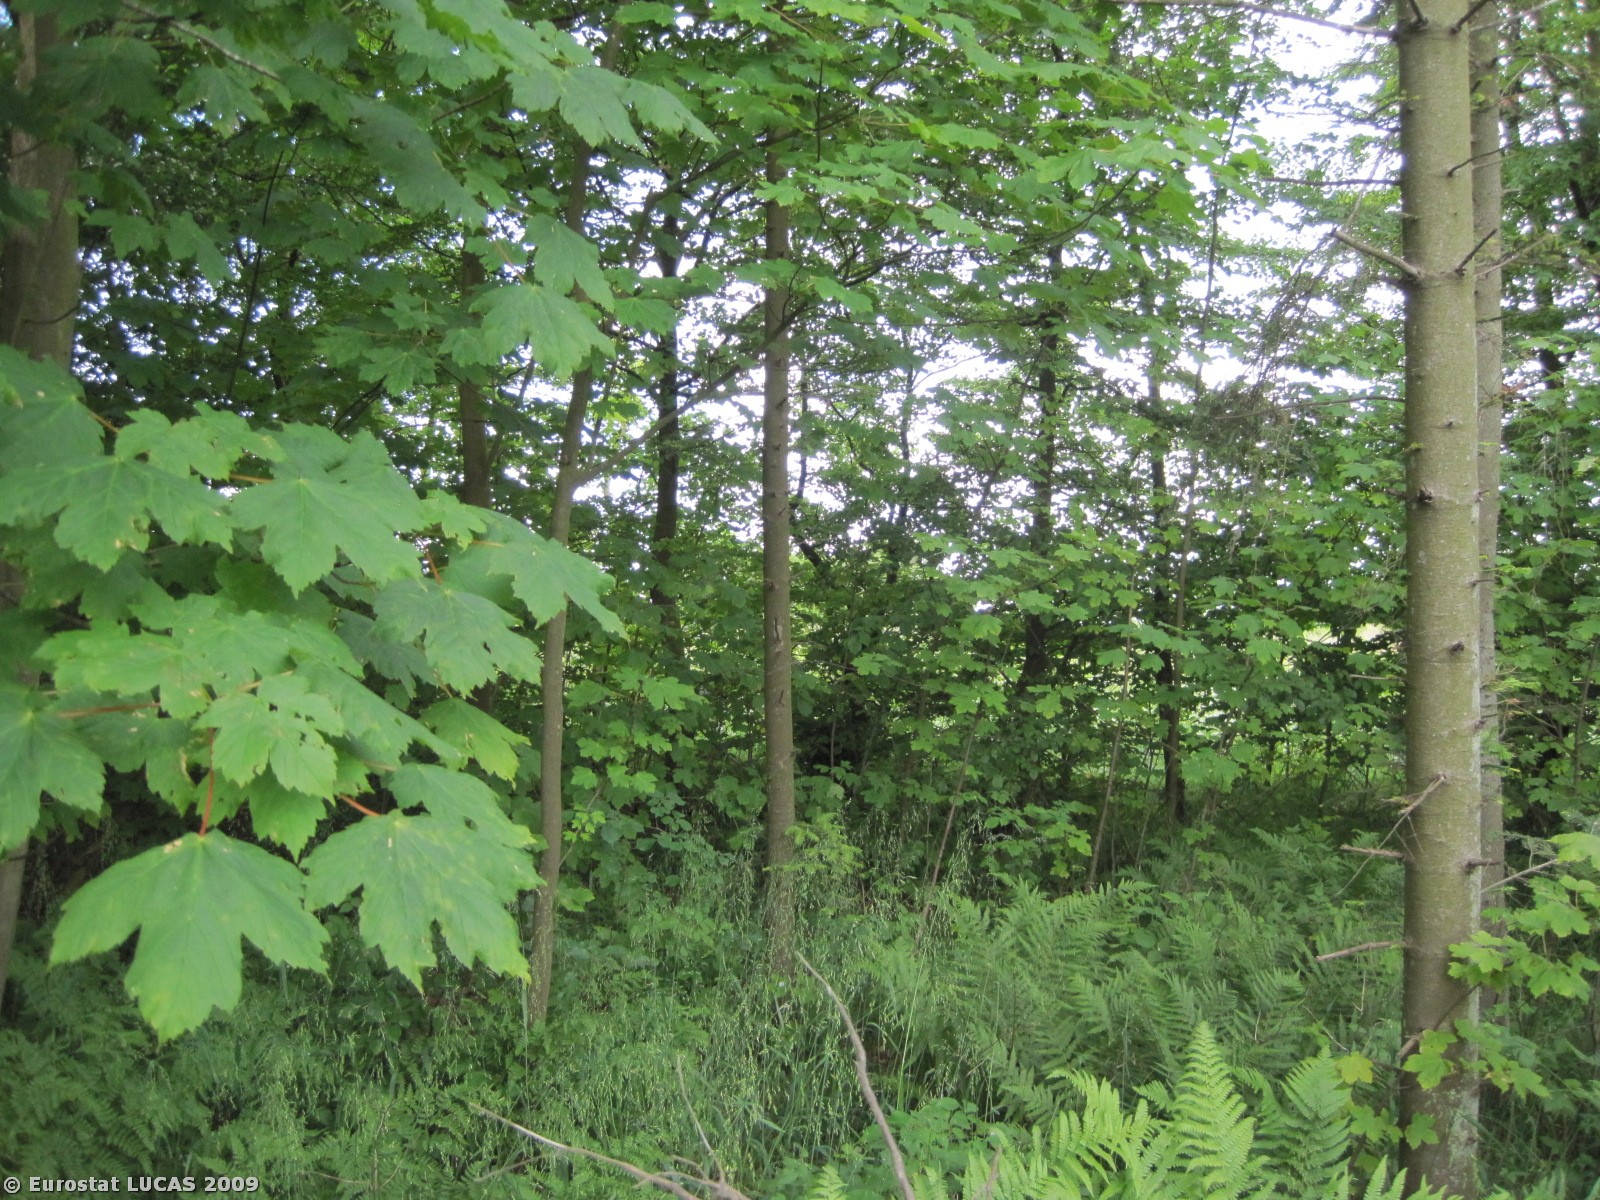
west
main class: Woodland
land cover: Mixed woodland
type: plantations and self-sown exotic forest
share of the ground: 50 - 75 %
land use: Agriculture (excluding fallow land and kitchen gardens)
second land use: Amenities, museums, leisure
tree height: > 5 m
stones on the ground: < 10 %
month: June
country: DK
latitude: 57.0865
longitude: 10.1483
